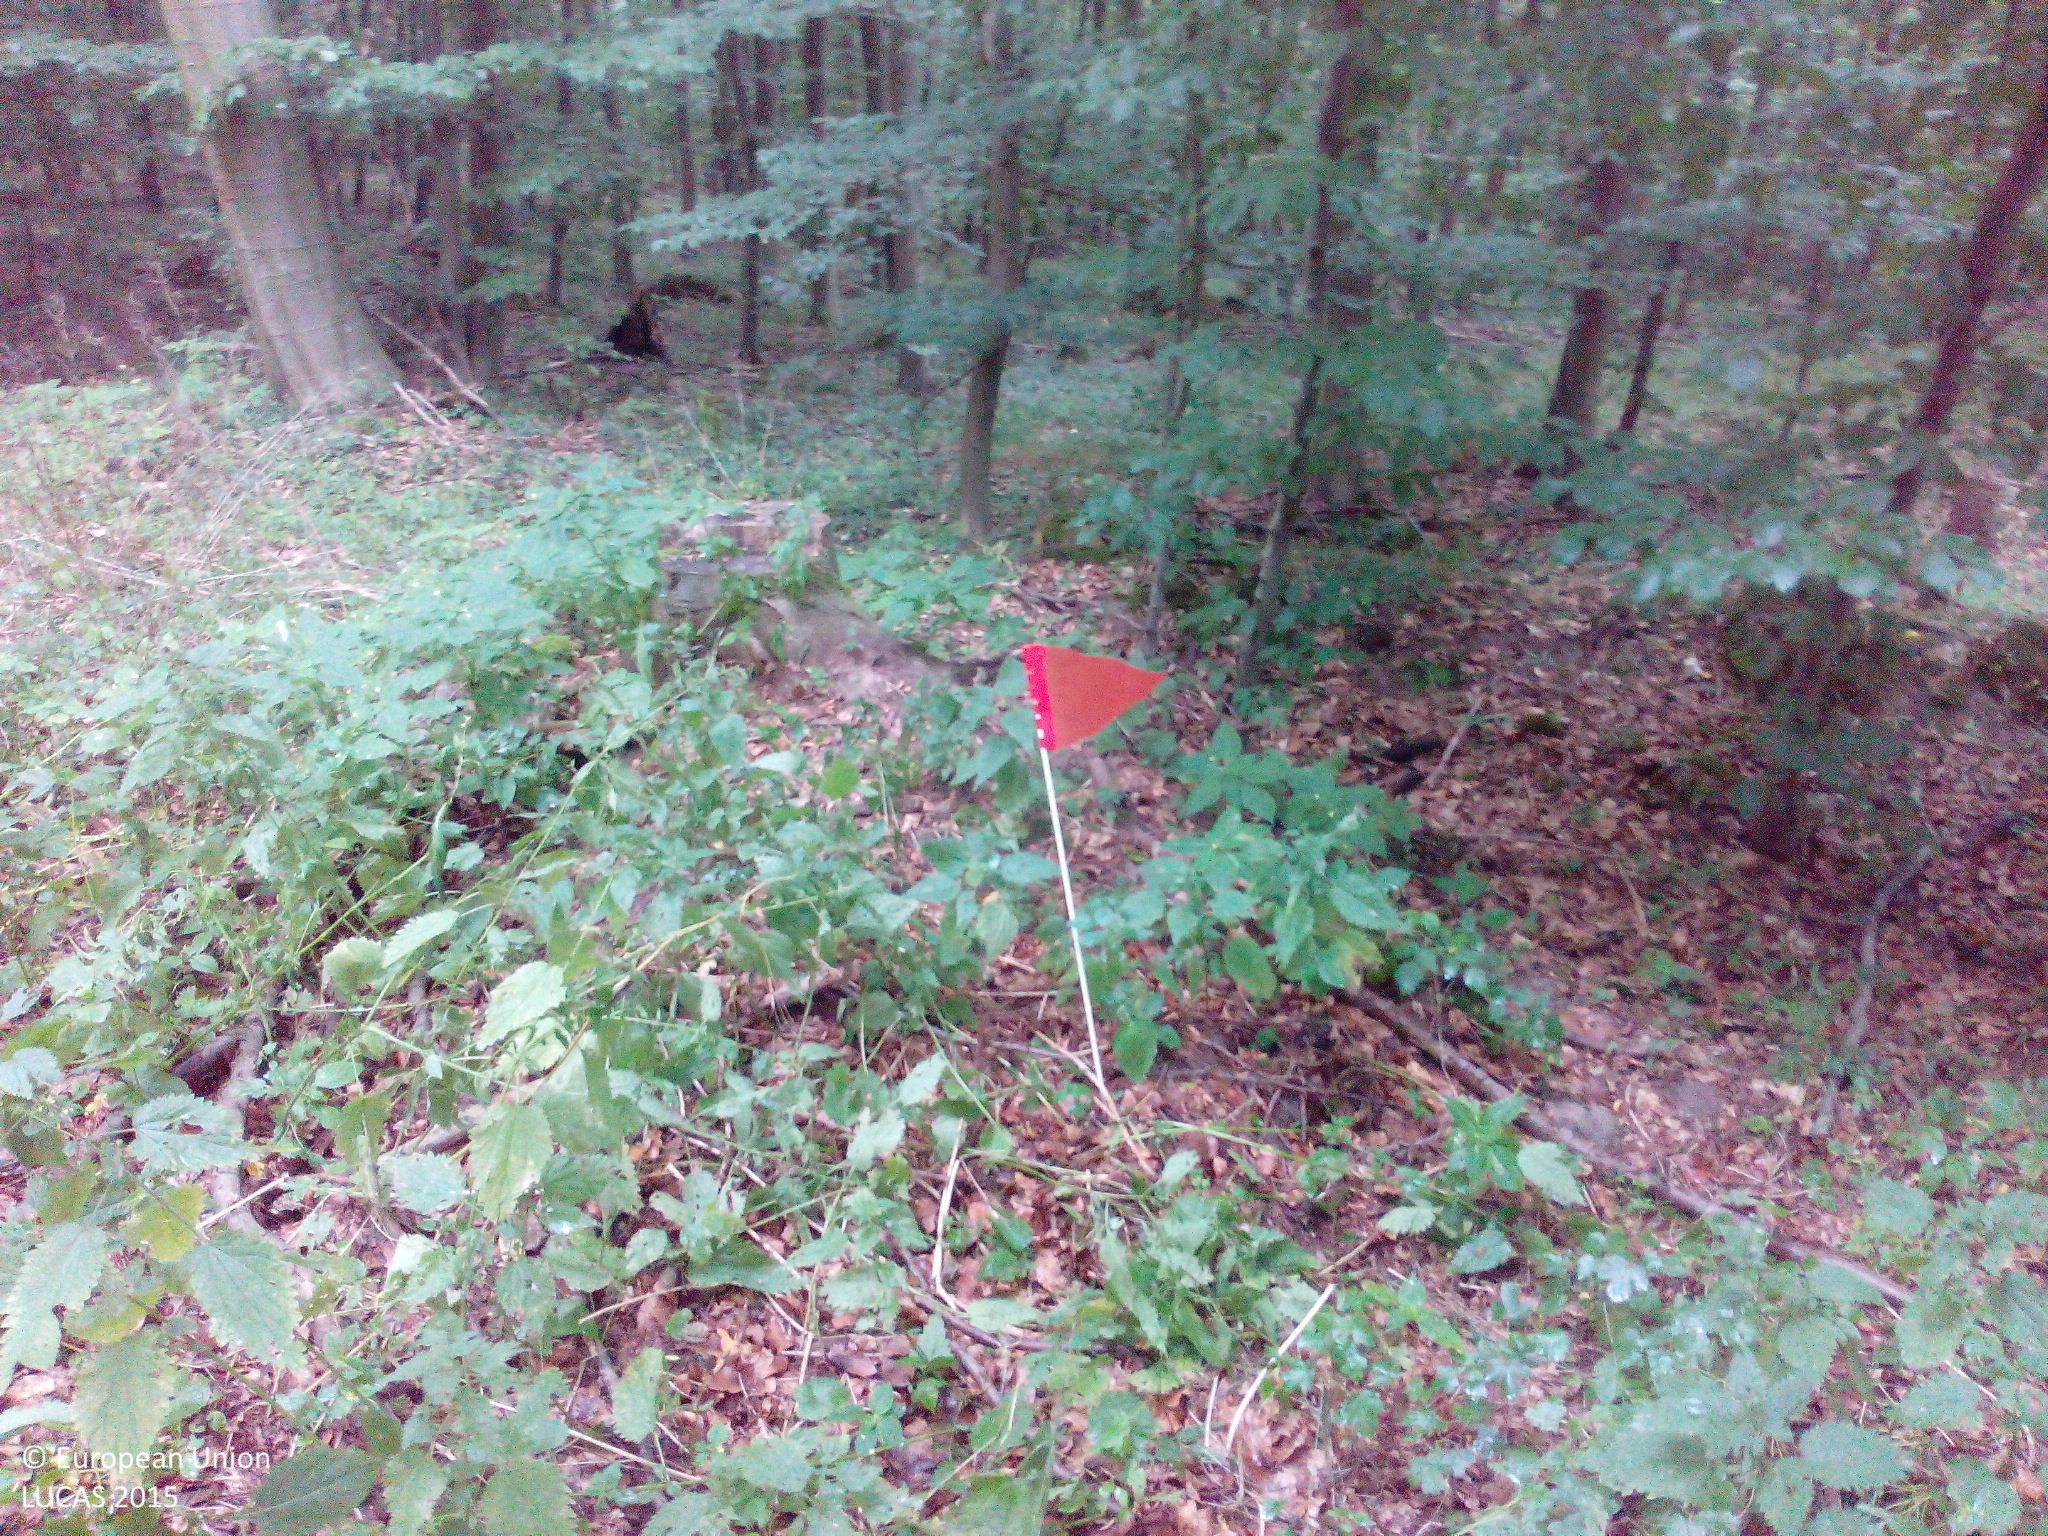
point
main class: Woodland
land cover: Broadleaved woodland
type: beech forest
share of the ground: > 75 %
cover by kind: broadleaved forest trees 85 %, unconsolidated bare surface 10 %, herbaceous plants 5 %
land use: Forestry
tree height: > 5 m
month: August
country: DE
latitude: 50.3469
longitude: 8.0189
